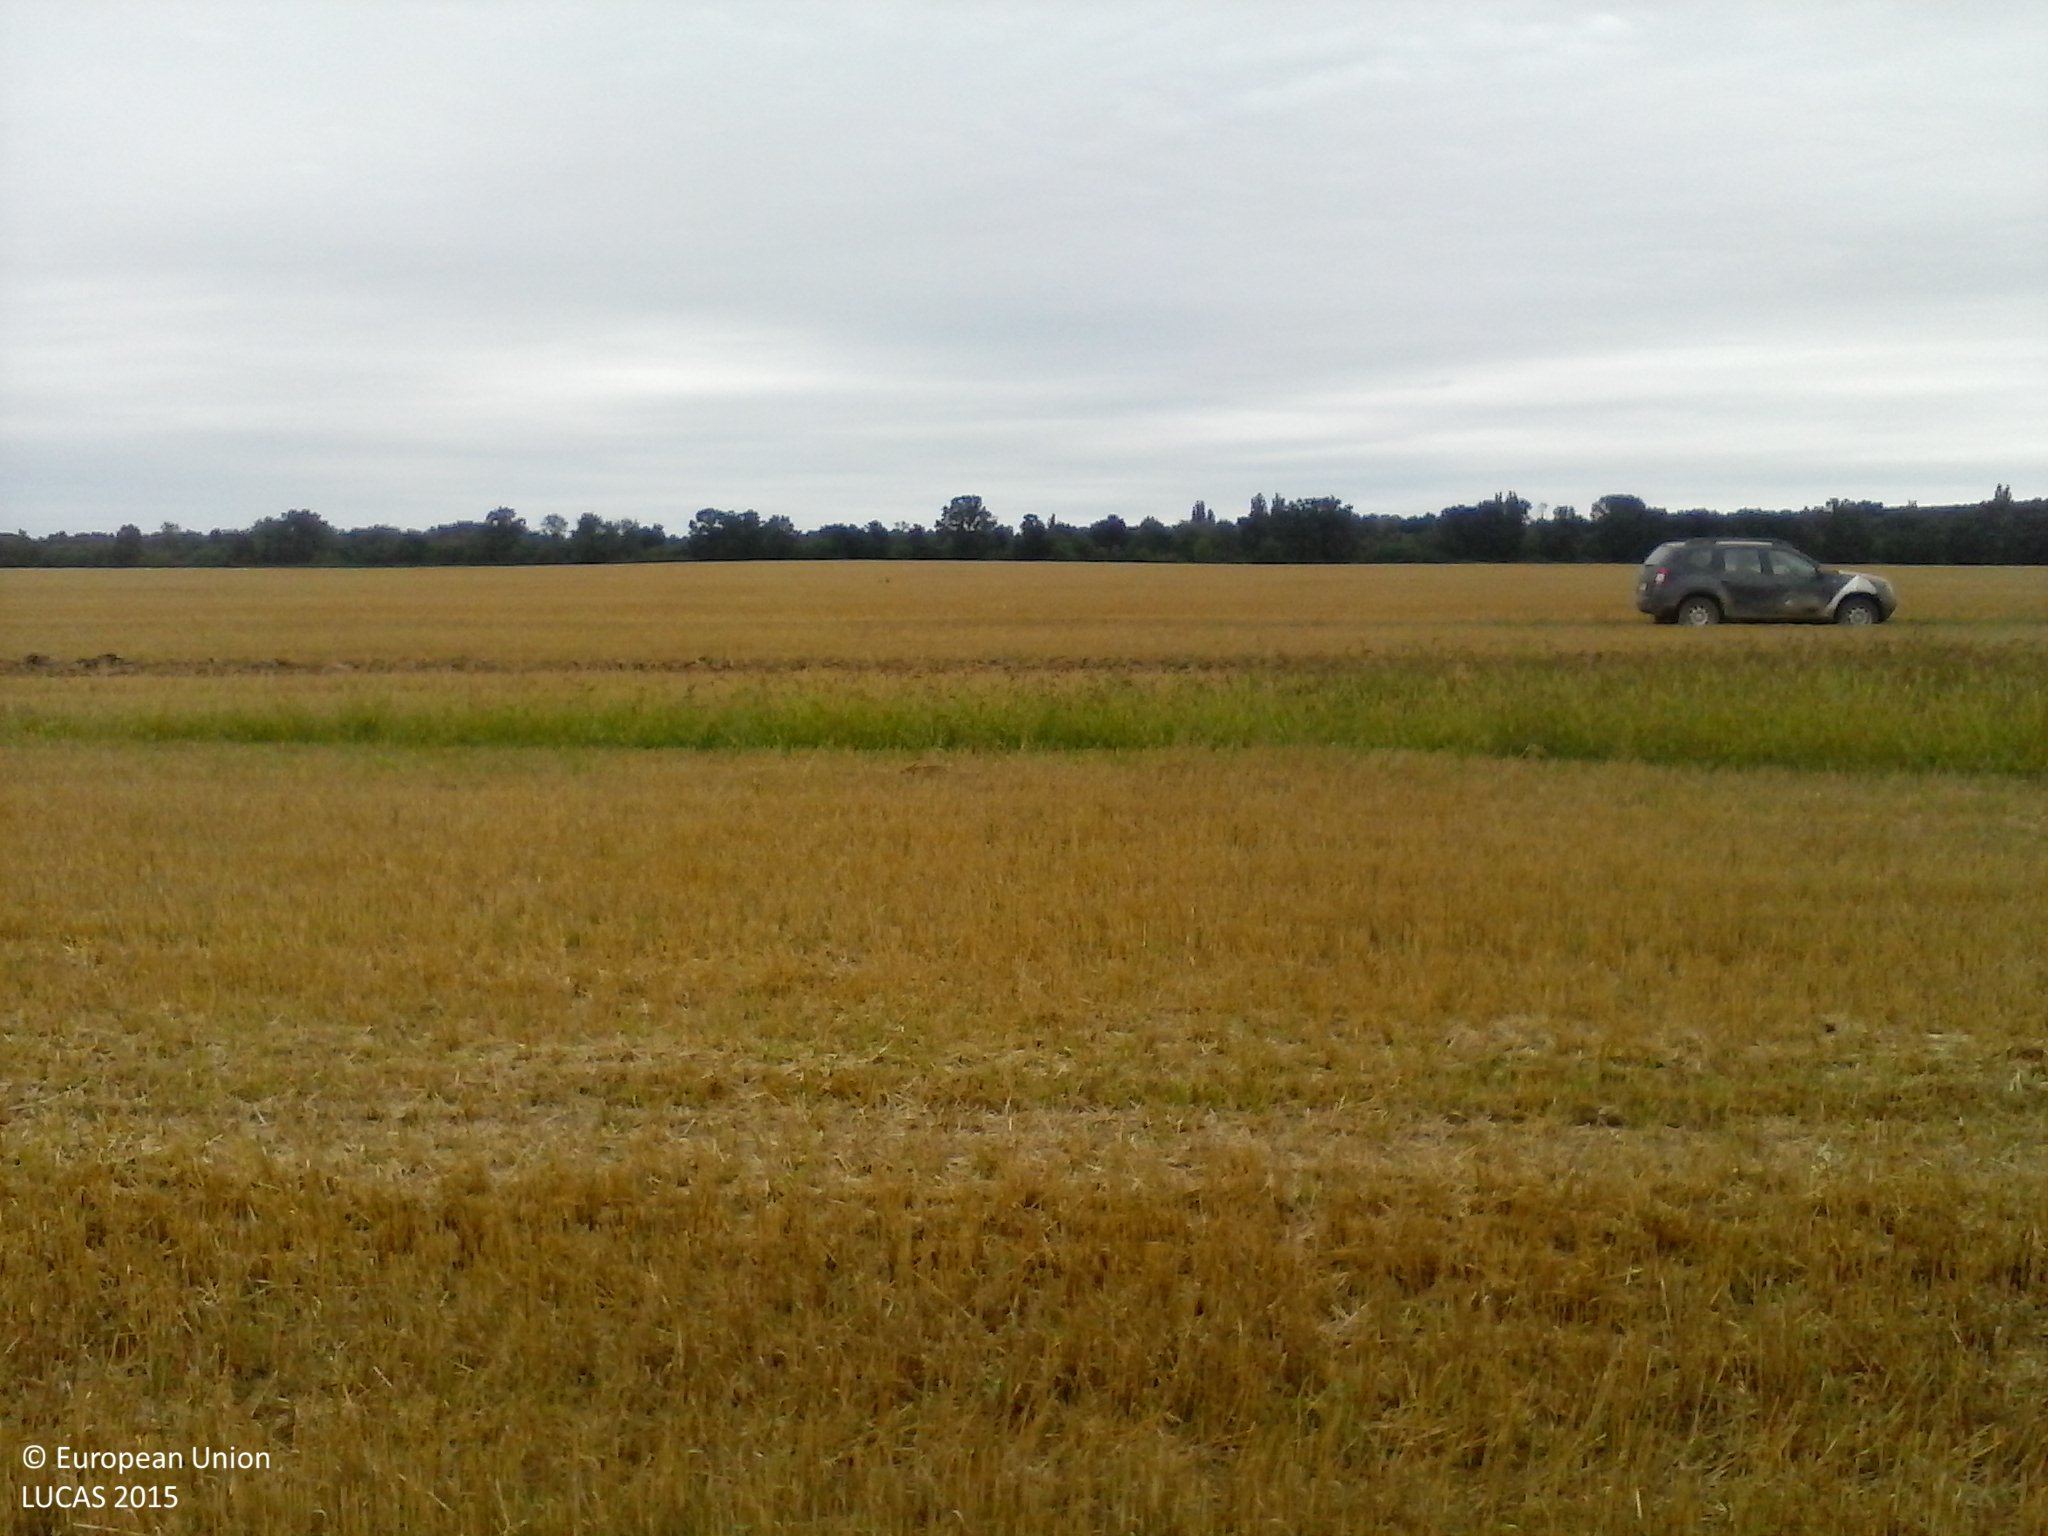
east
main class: Cropland
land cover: Common wheat
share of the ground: > 75 %
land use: Agriculture (excluding fallow land and kitchen gardens)
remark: Harvested field
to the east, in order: Common wheat
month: July
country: HU
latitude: 46.0773
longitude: 17.6461
